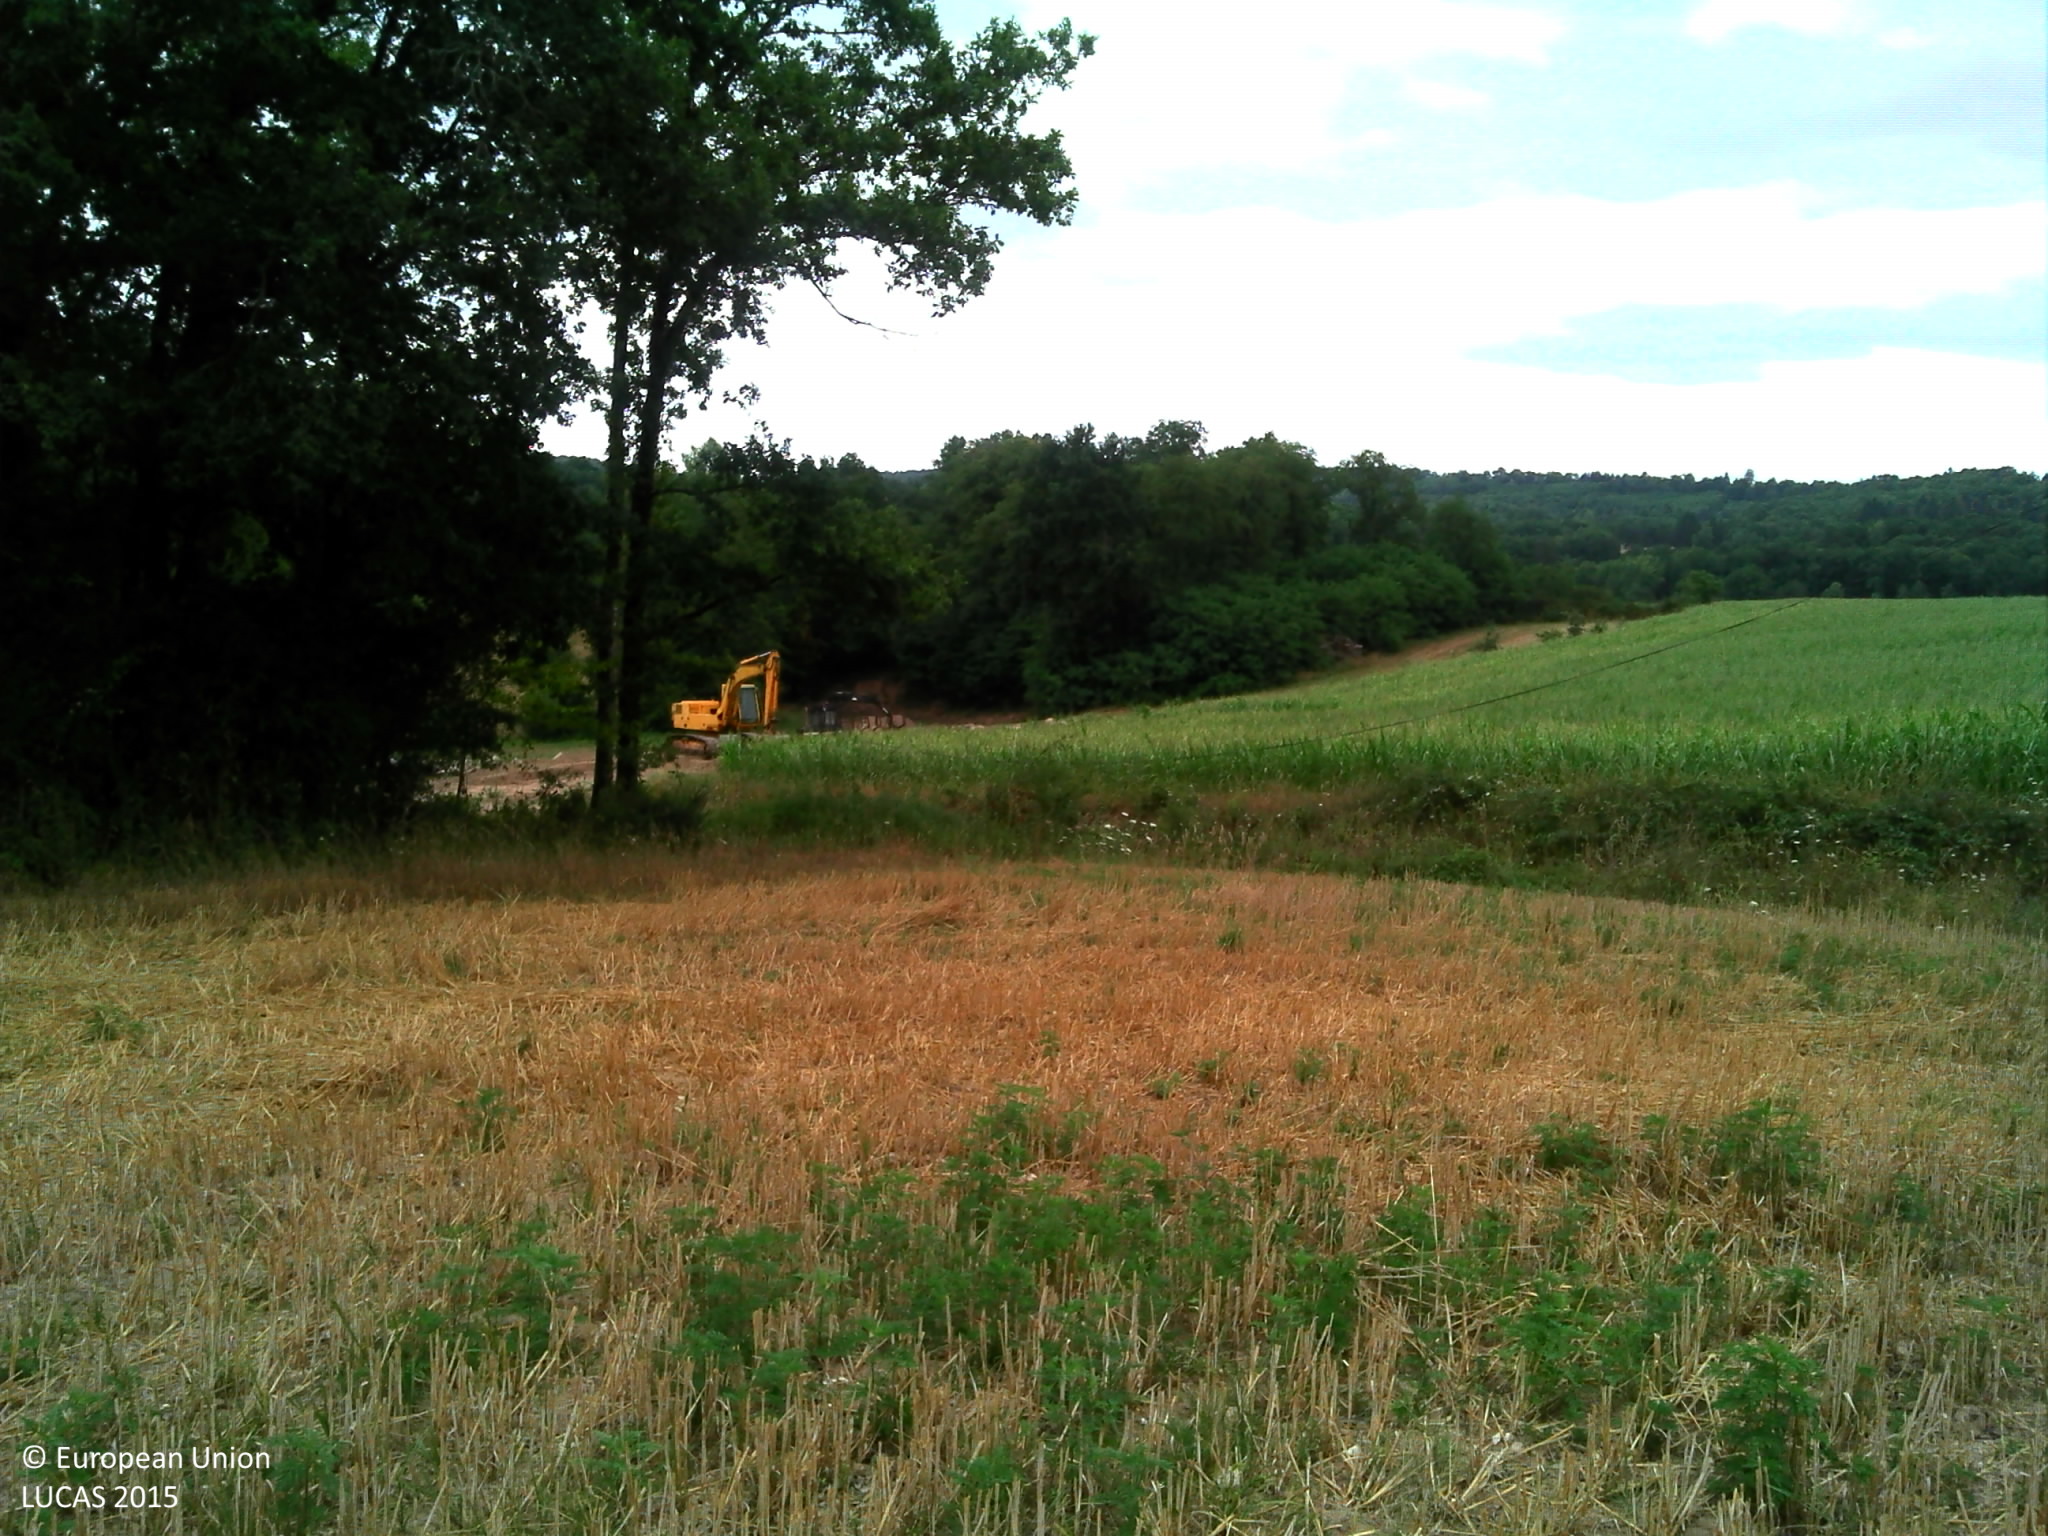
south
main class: Cropland
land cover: Common wheat
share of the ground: < 10 %
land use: Agriculture (excluding fallow land and kitchen gardens)
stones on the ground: < 10 %
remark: Harvested field
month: July
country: FR
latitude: 45.5801
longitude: 0.6708
